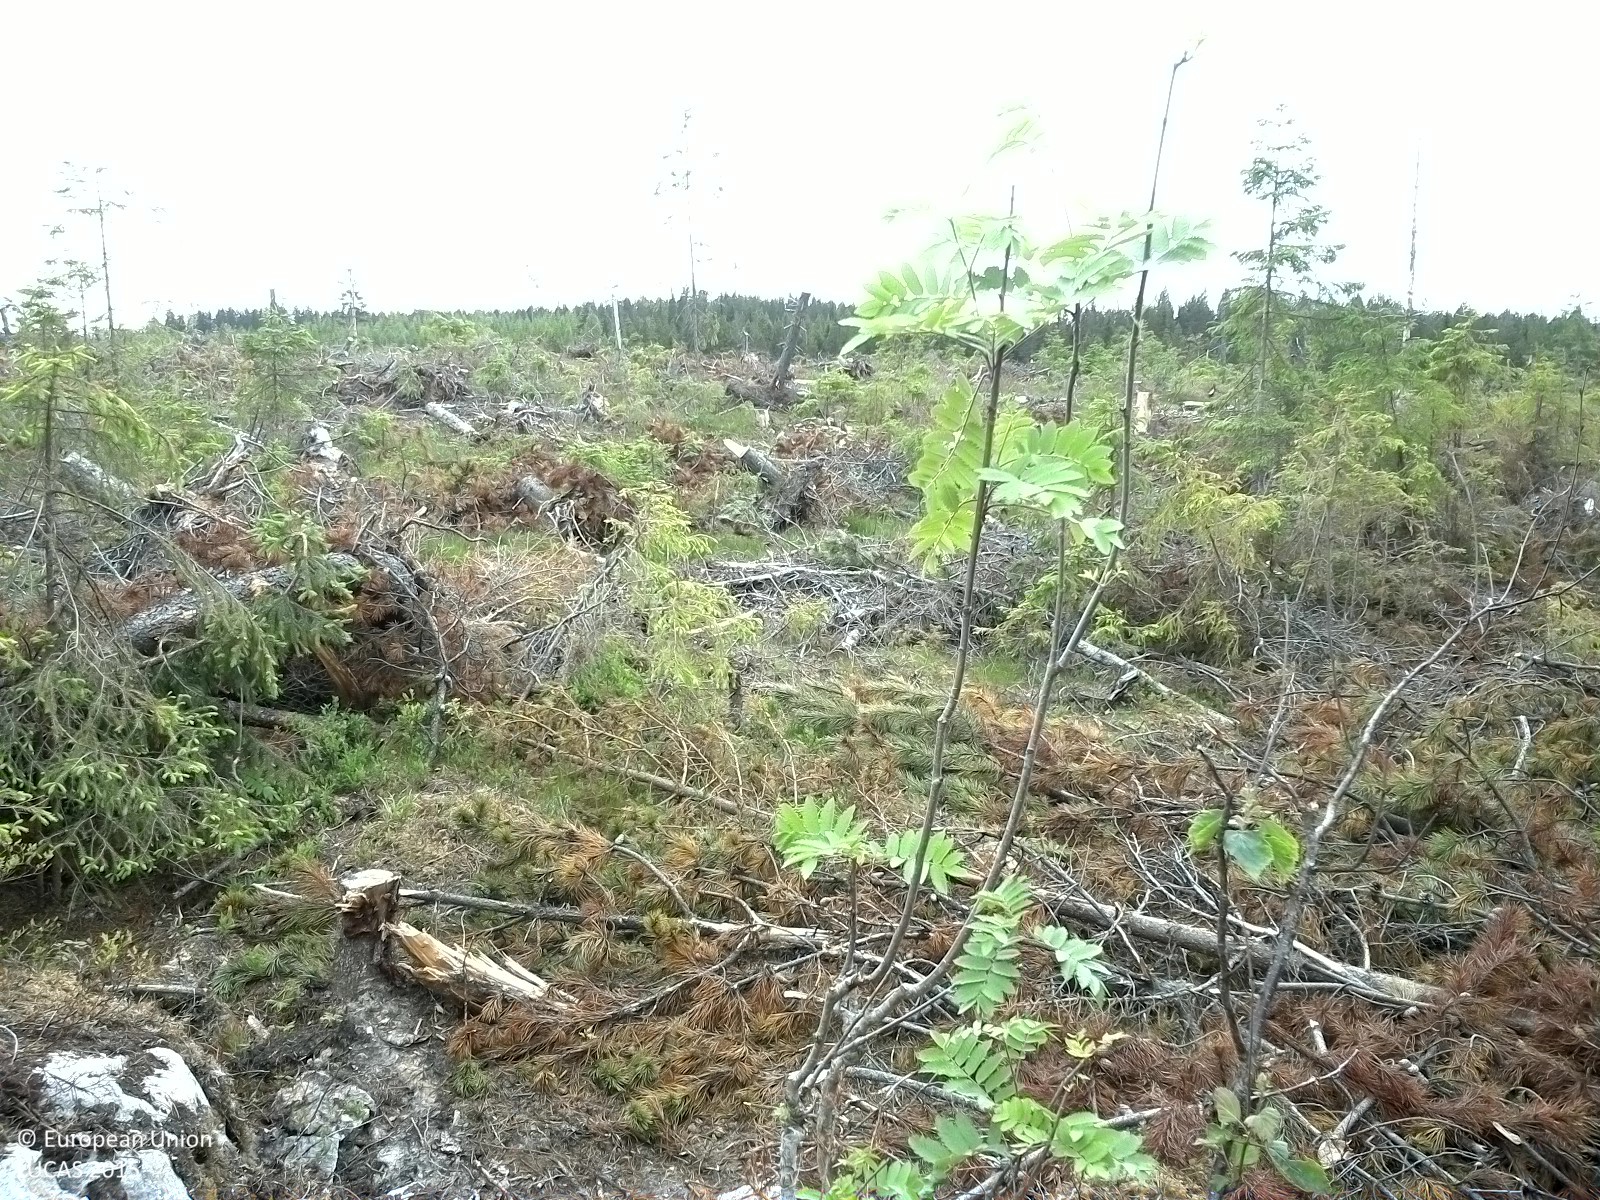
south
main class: Woodland
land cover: Other coniferous woodland
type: boreal forest
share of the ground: 10 - 25 %
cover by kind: coniferous forest trees 25 %, herbaceous plants 25 %
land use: Forestry
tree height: < 5 m
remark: Clear cut
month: June
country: SE
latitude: 62.0263
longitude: 16.3452
